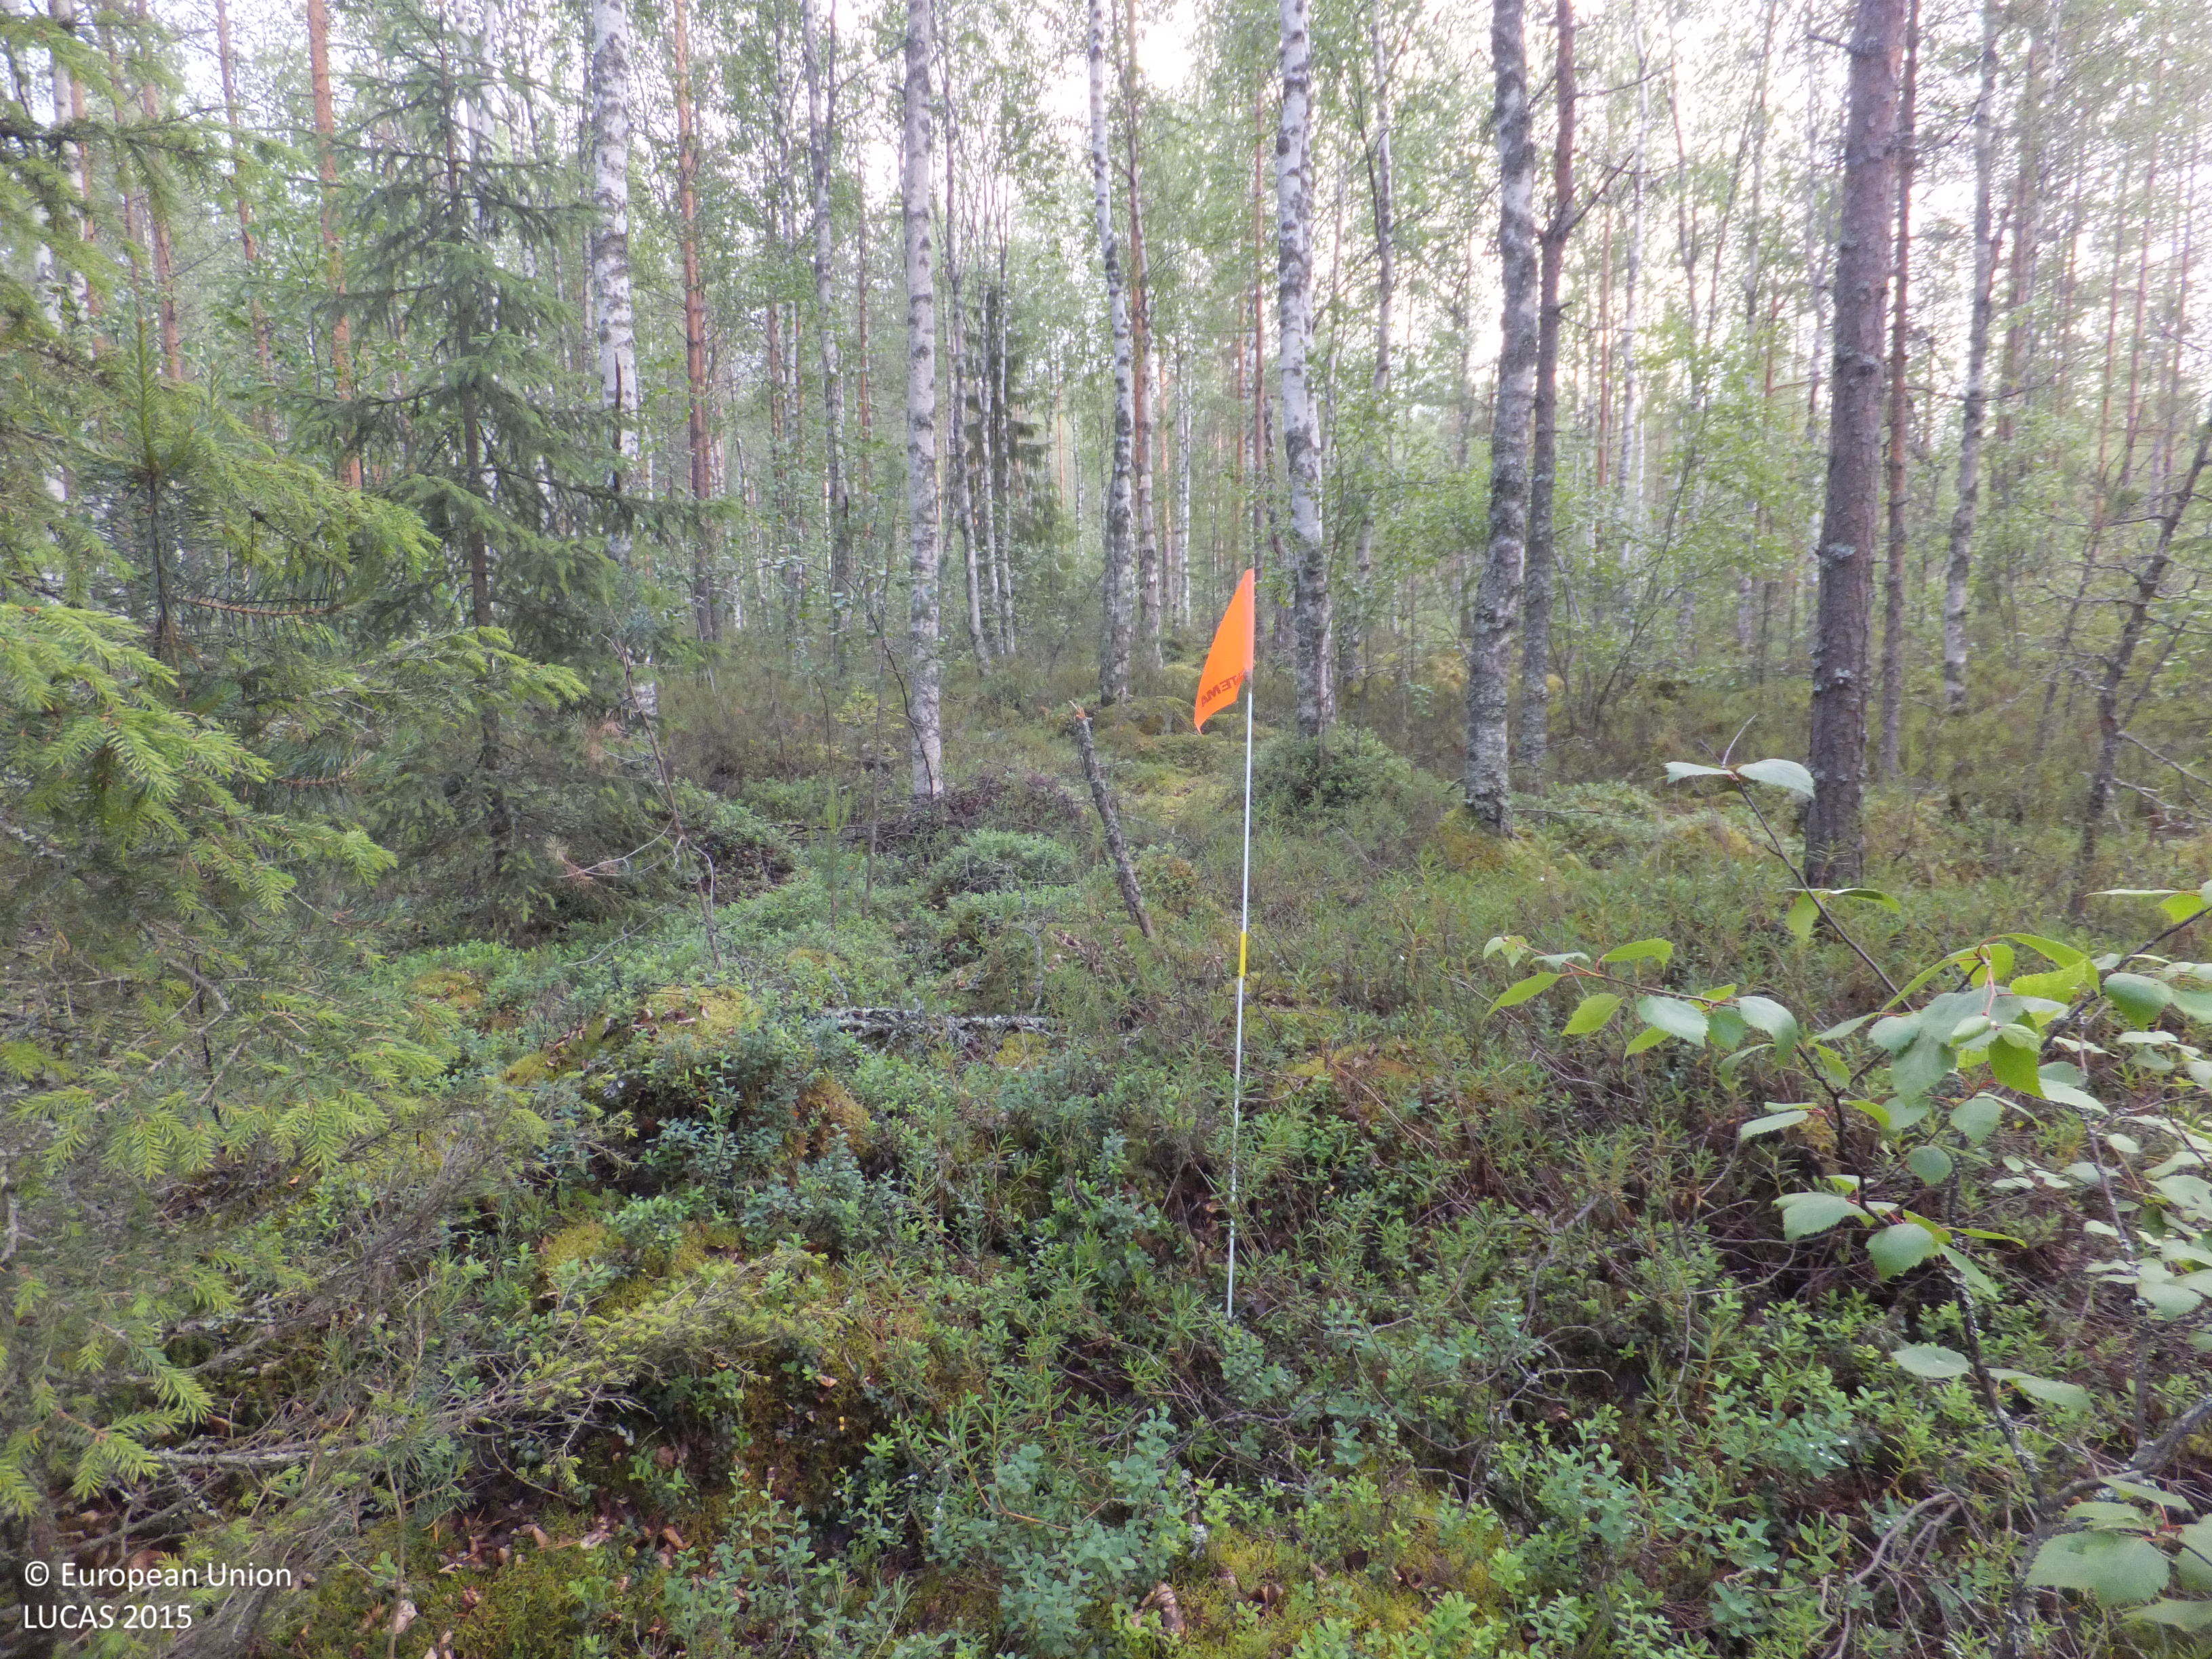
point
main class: Woodland
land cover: Pine dominated mixed woodland
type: boreal forest
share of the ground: > 75 %
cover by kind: broadleaved forest trees 60 %, coniferous forest trees 20 %, shrubs 10 %, lichens and mosses 10 %
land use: Forestry
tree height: > 5 m
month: July
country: FI
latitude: 63.0108
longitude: 24.4829
